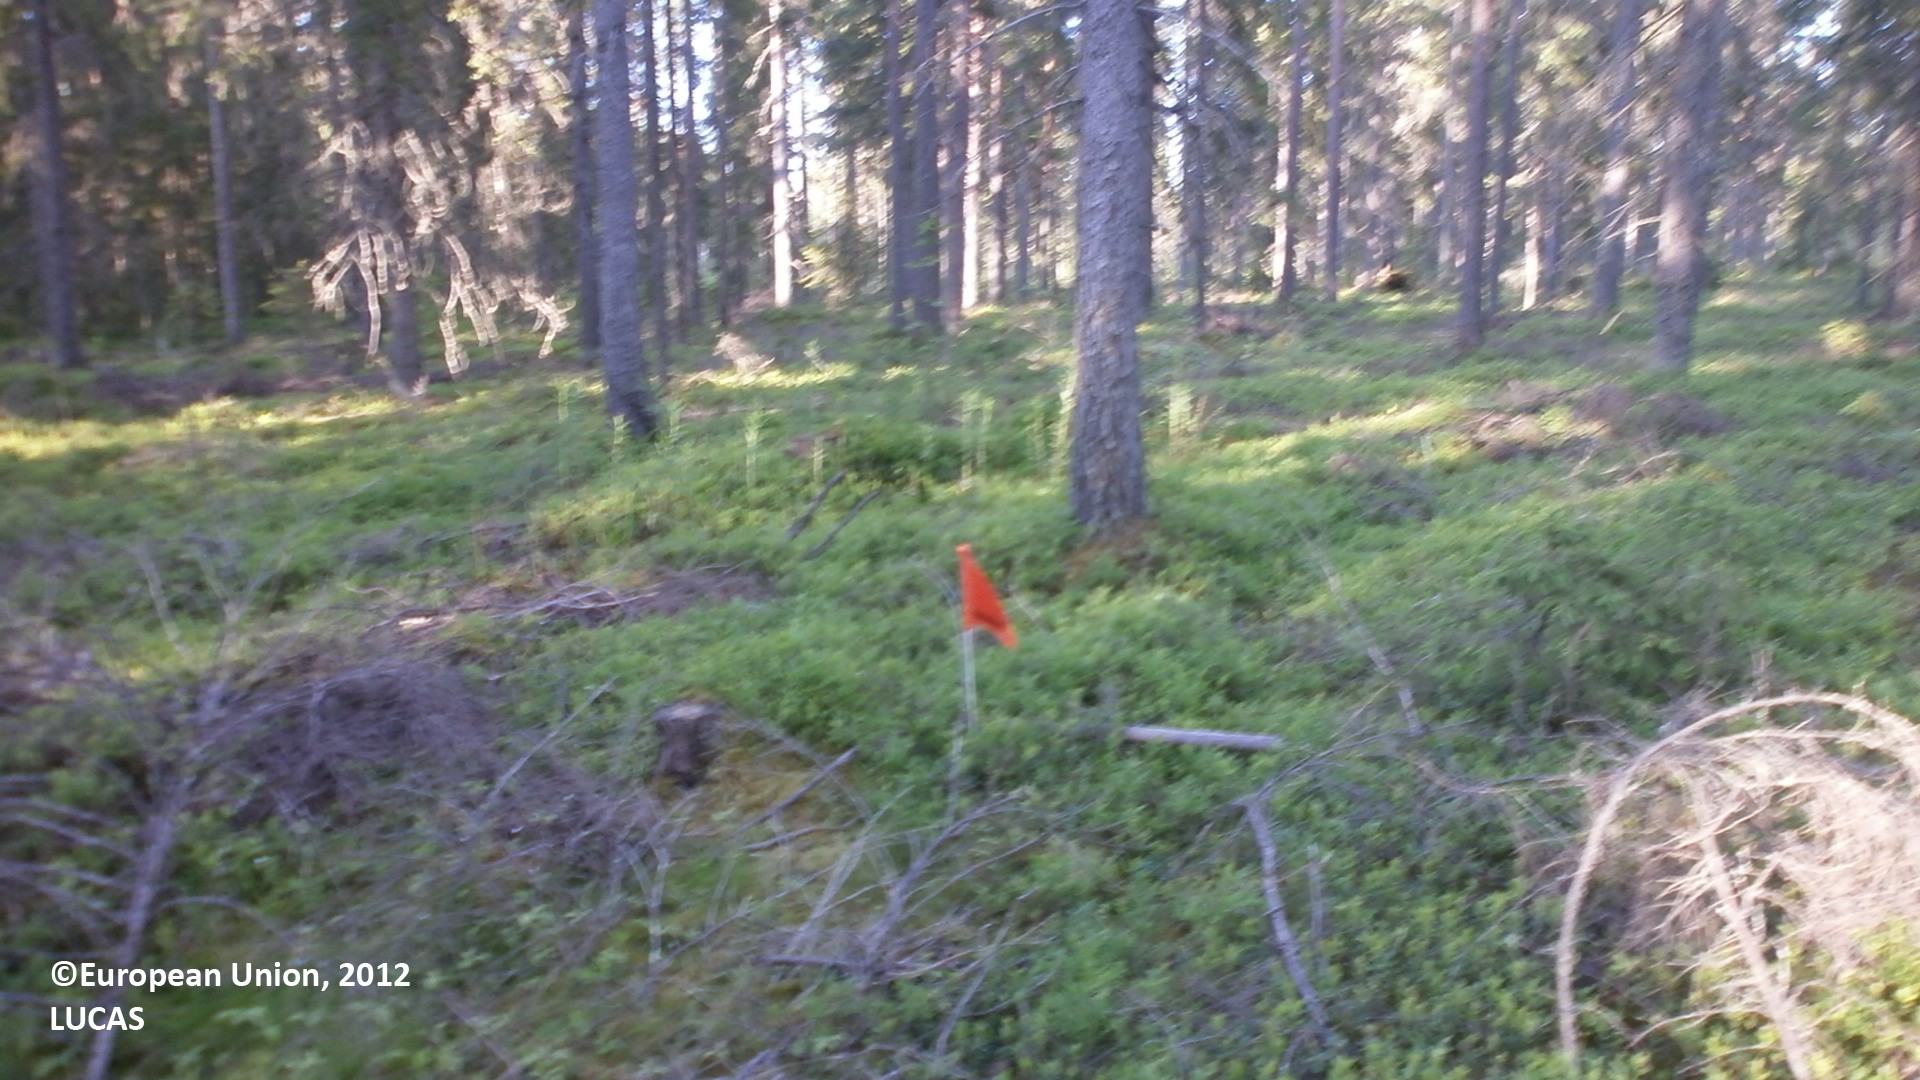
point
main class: Woodland
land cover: Spruce dominated coniferous woodland
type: boreal forest
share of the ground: 25 - 50 %
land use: Forestry
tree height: > 5 m
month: June
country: FI
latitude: 64.3258
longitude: 24.9963
